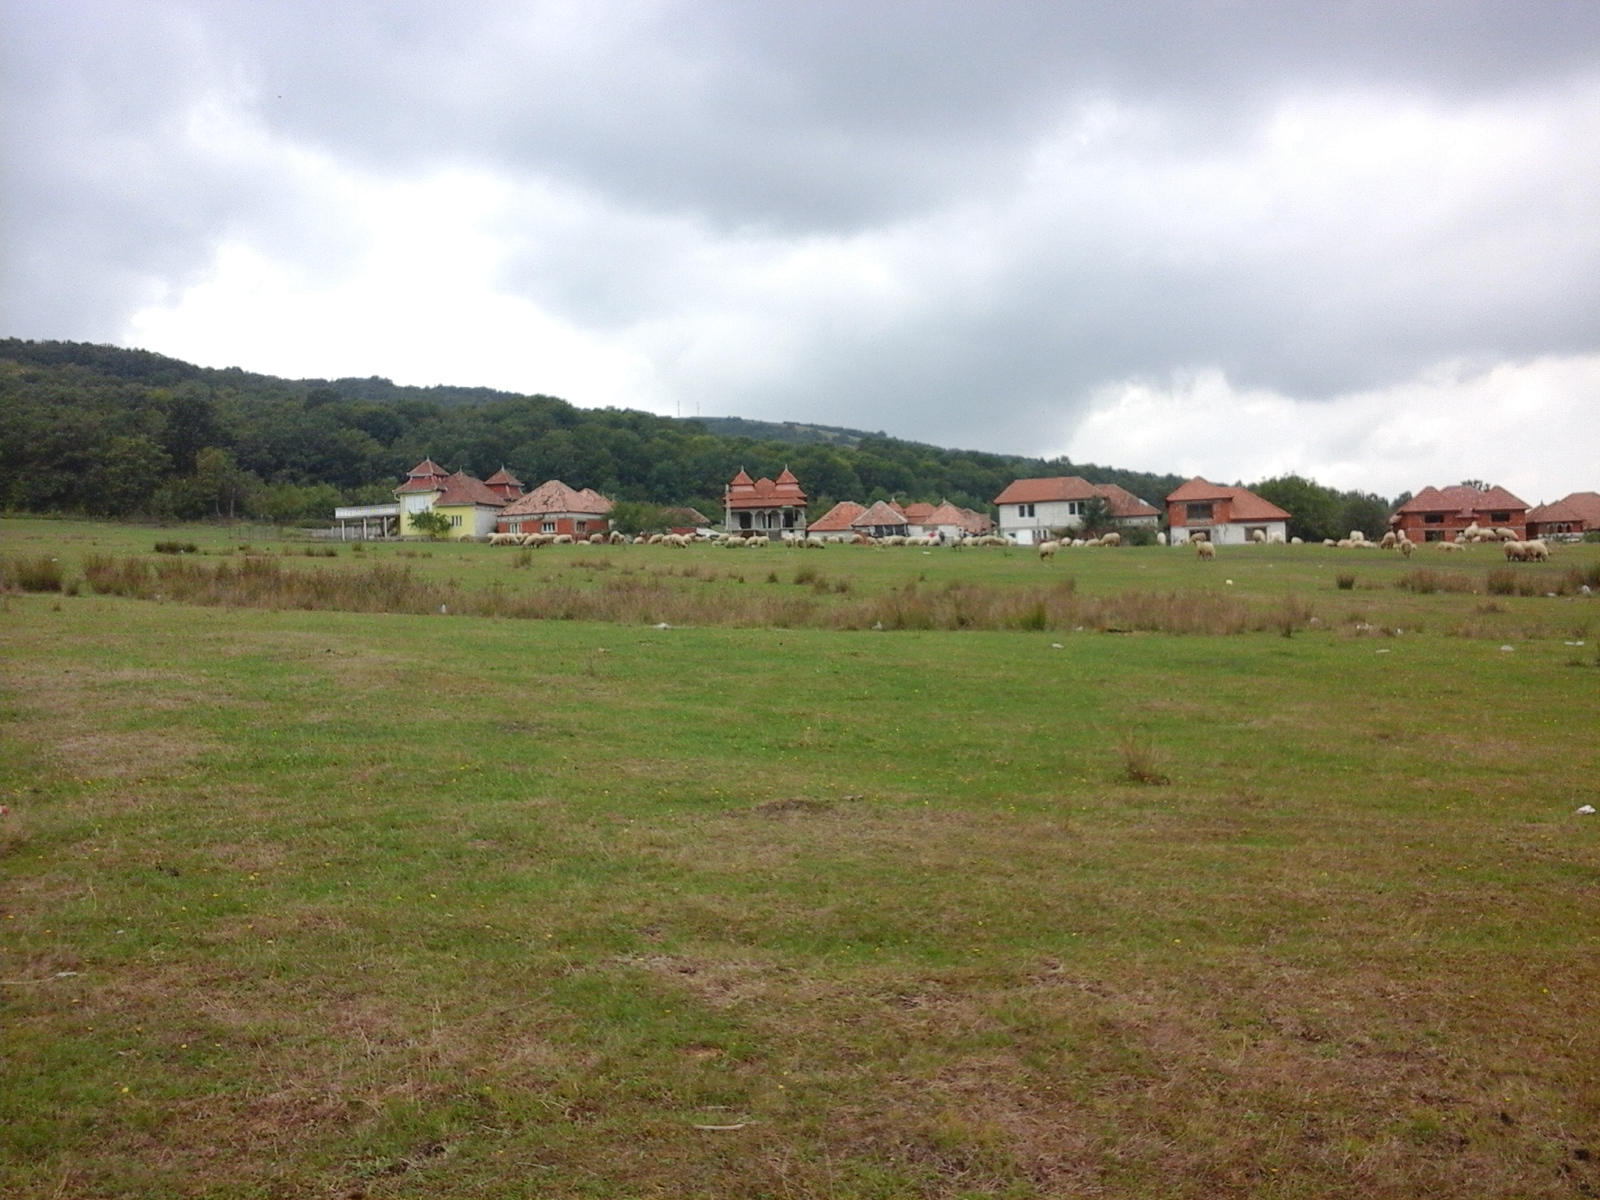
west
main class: Grassland
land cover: Grassland without tree/shrub cover
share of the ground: > 75 %
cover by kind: herbaceous plants 100 %
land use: Agriculture (excluding fallow land and kitchen gardens)
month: September
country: RO
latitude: 46.7384
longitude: 22.2334
